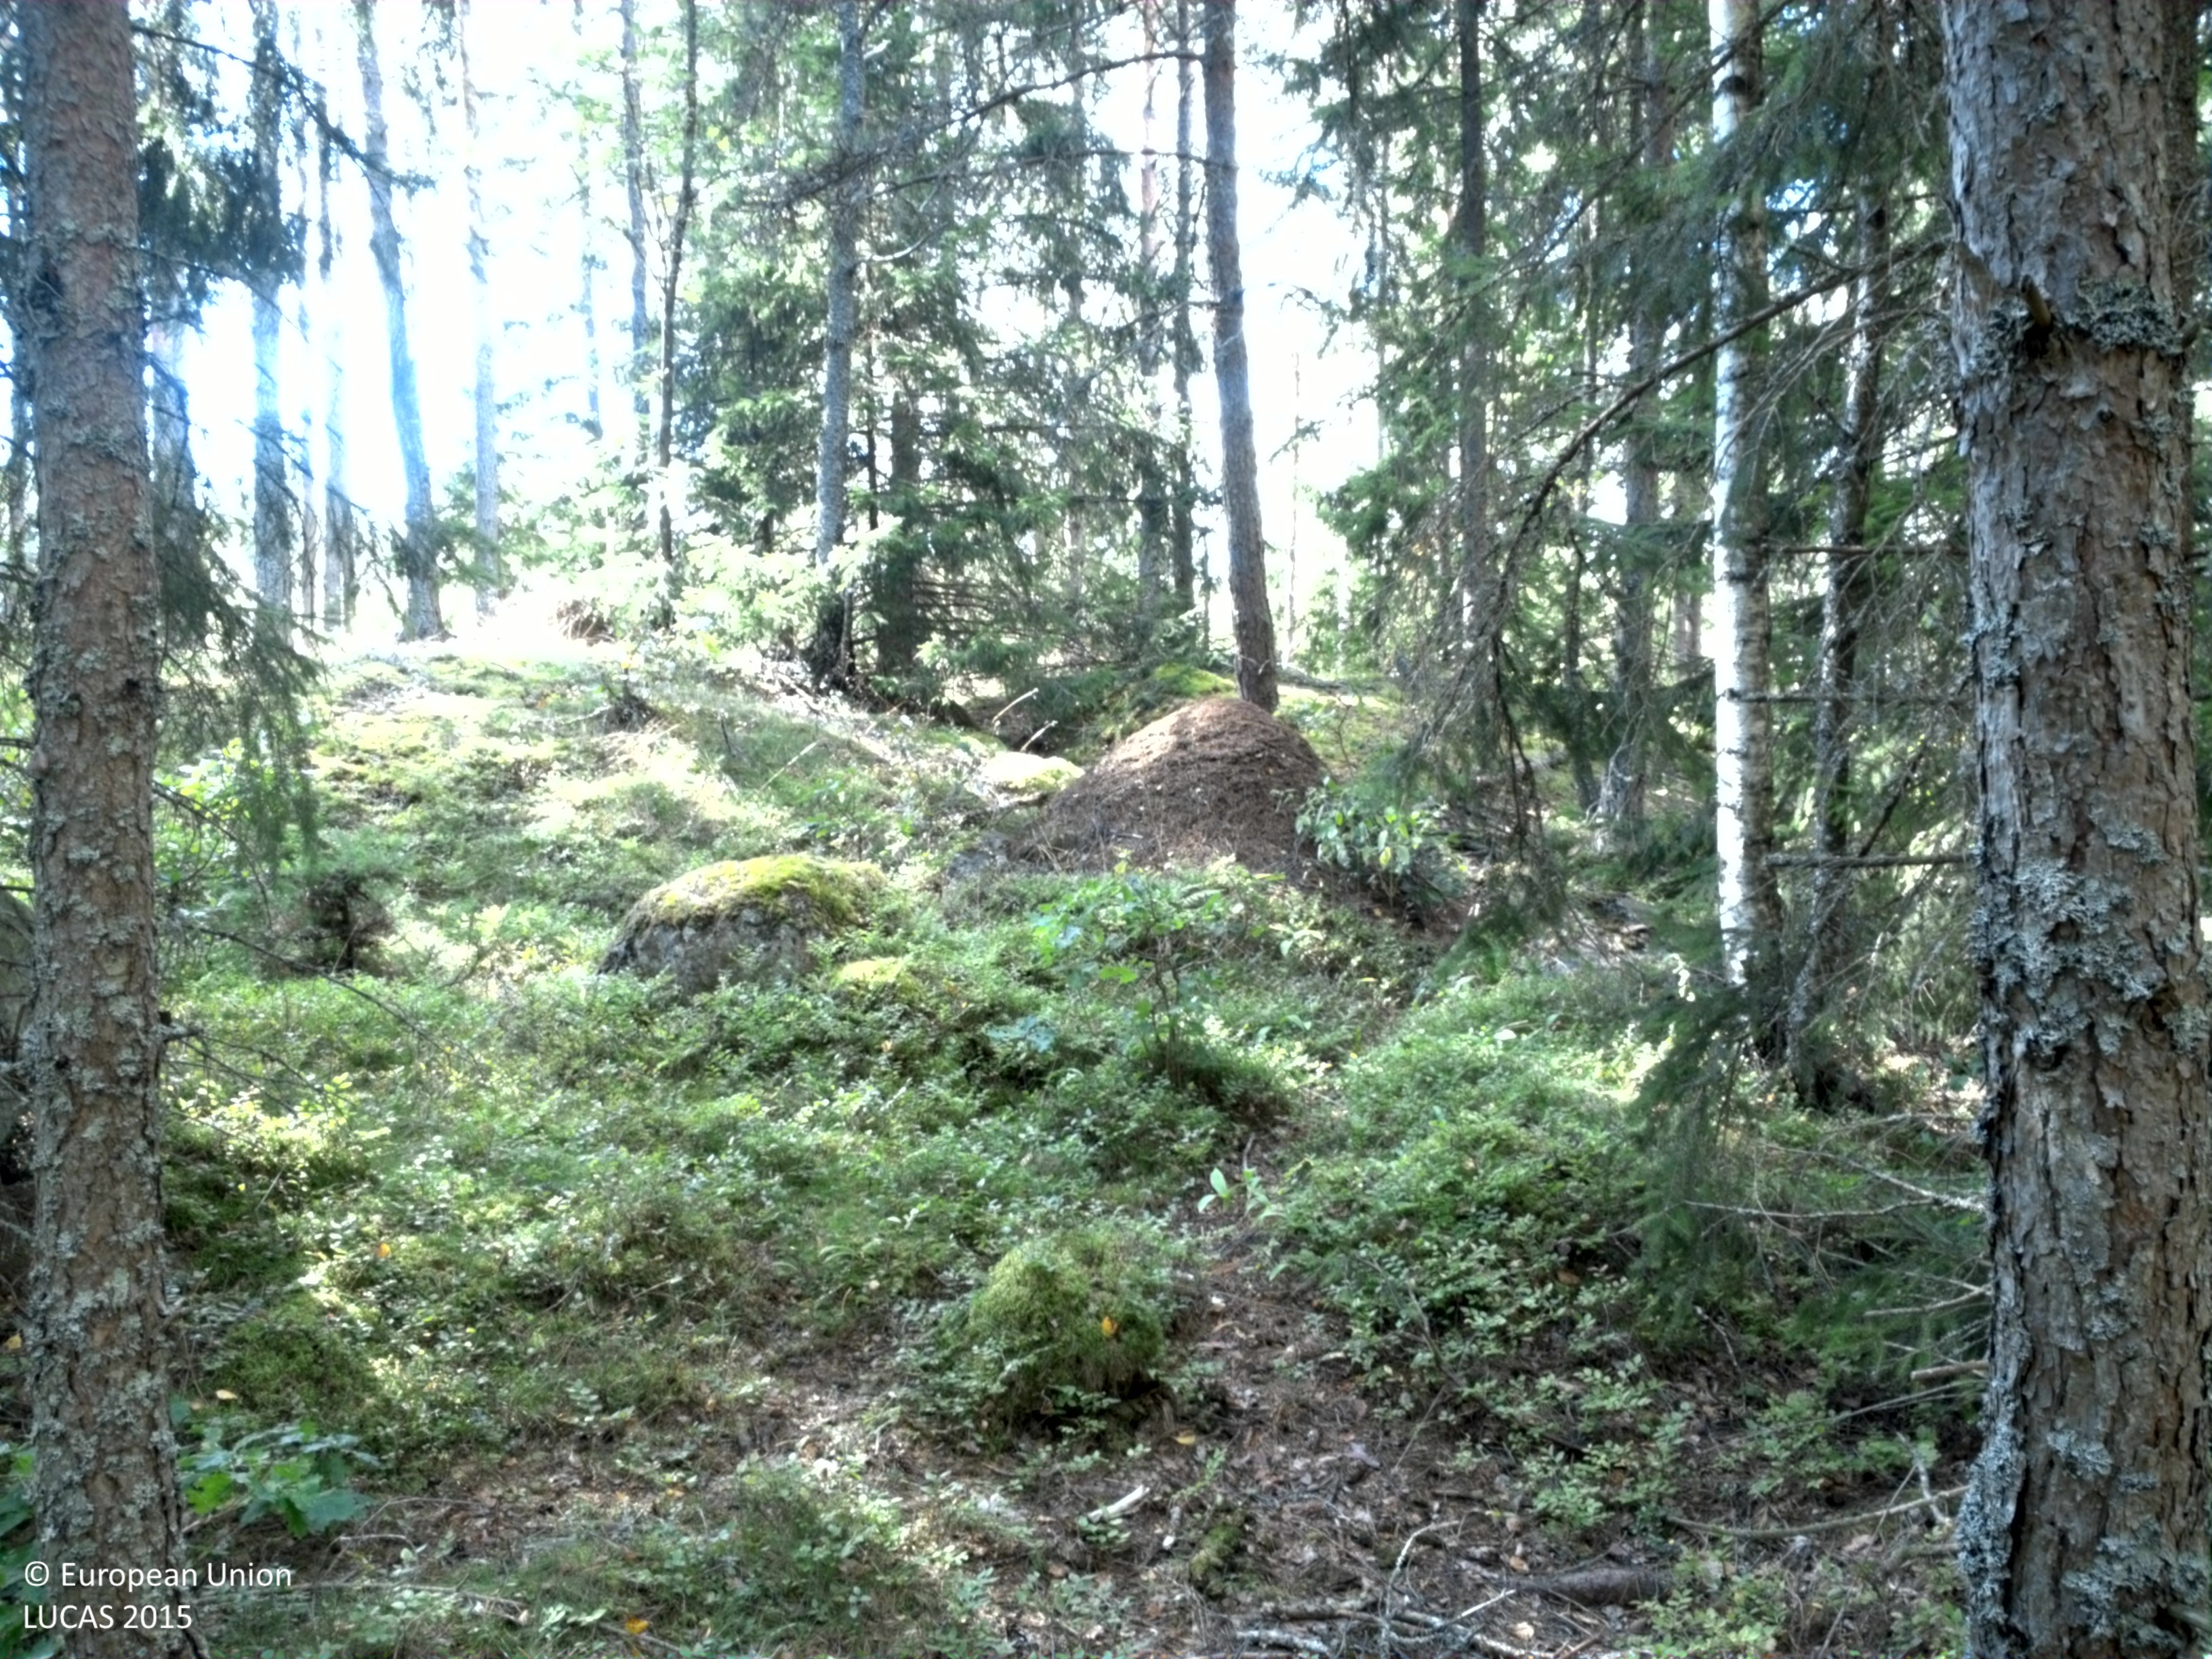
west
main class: Woodland
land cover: Spruce dominated coniferous woodland
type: boreal forest
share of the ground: 50 - 75 %
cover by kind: coniferous forest trees 70 %, lichens and mosses 20 %, broadleaved forest trees 5 %, shrubs 5 %
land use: Forestry
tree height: > 5 m
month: August
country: SE
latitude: 59.6112
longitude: 16.9582
